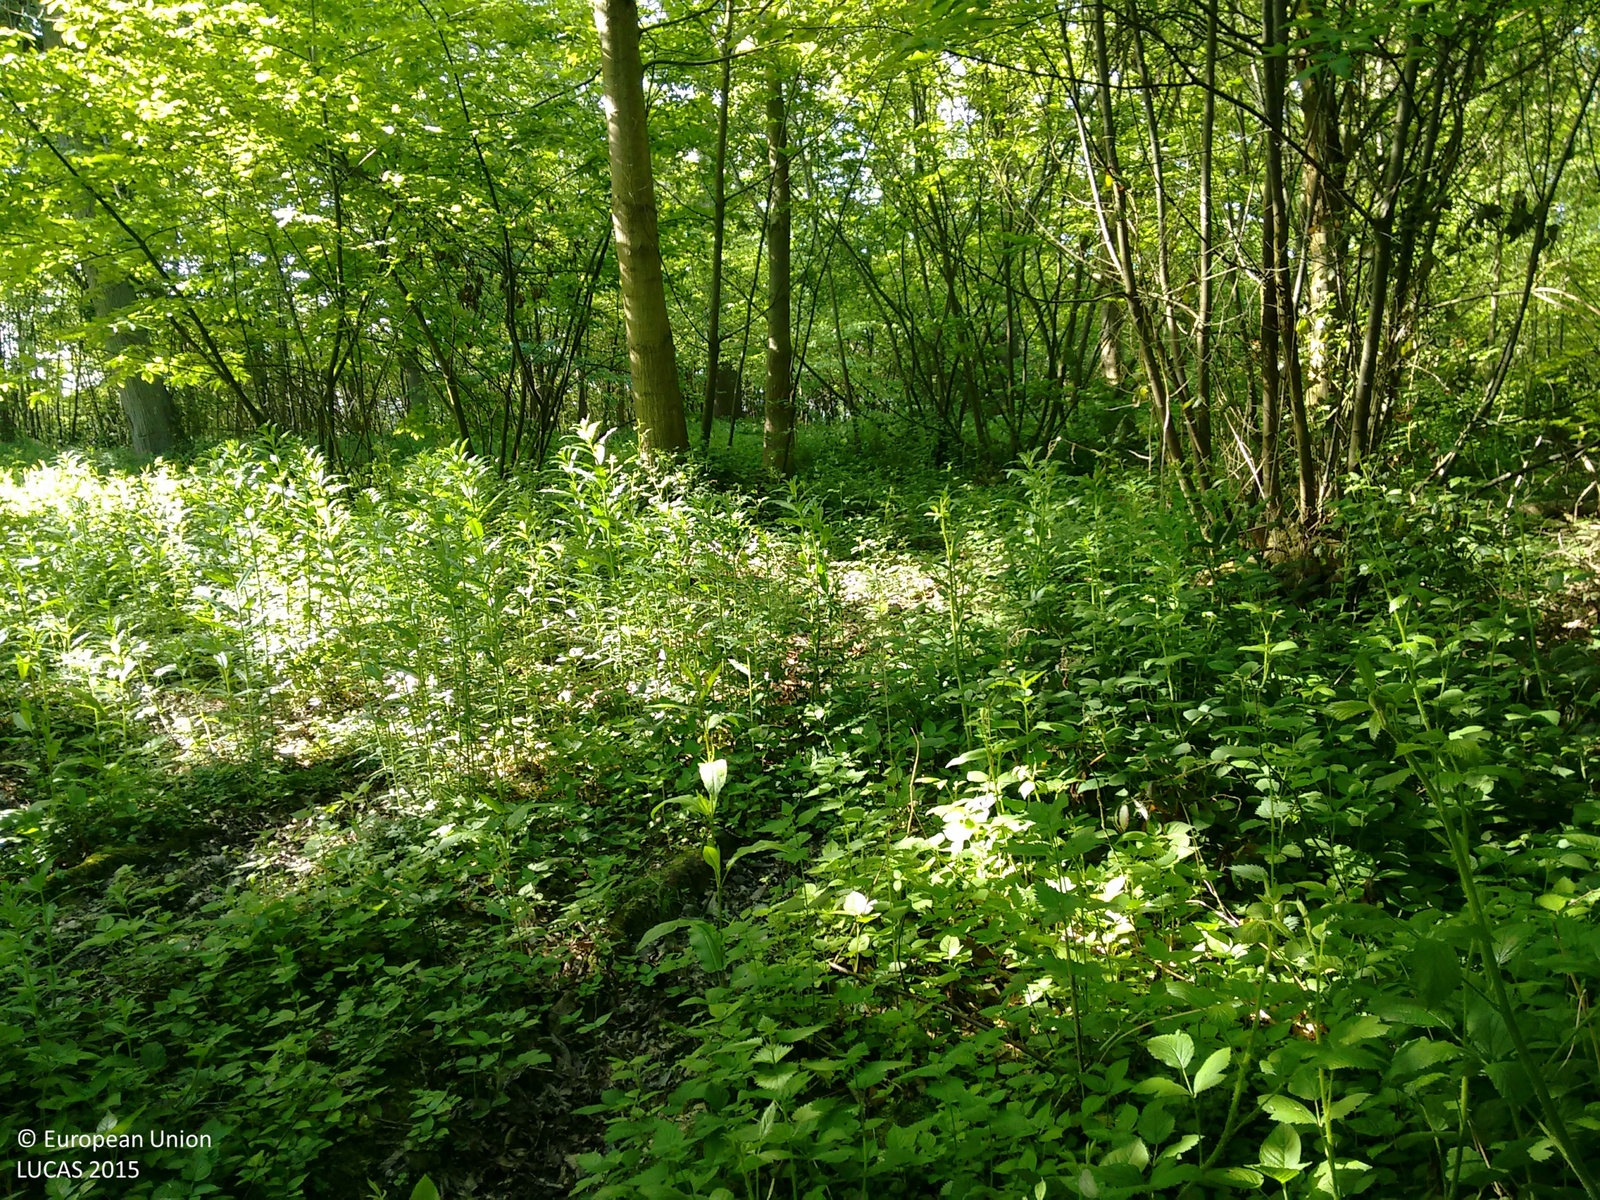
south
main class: Woodland
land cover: Broadleaved woodland
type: exotic forest
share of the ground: > 75 %
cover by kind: broadleaved forest trees 50 %, shrubs 40 %, herbaceous plants 10 %
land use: Forestry
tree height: > 5 m
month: May
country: GB
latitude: 51.2183
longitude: 1.2018
